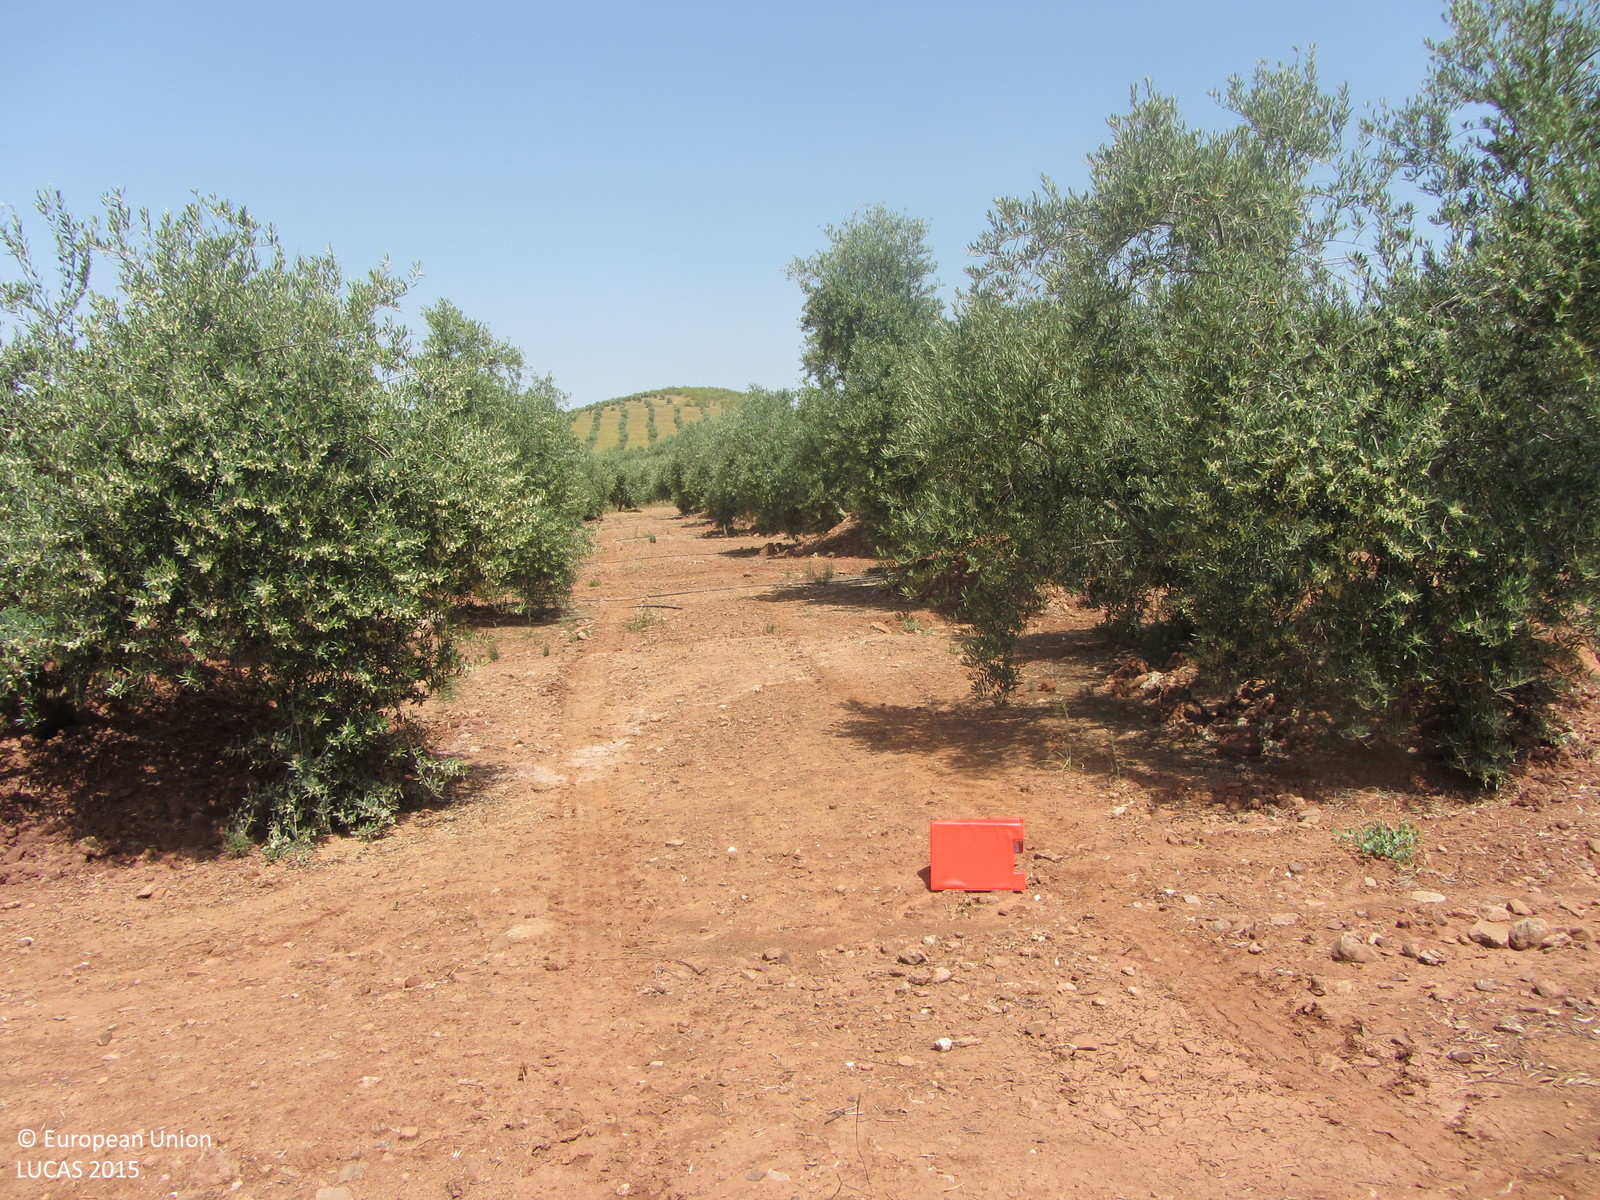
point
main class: Cropland
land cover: Olive groves
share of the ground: 50 - 75 %
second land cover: Other bare soil
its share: > 75 %
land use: Agriculture (excluding fallow land and kitchen gardens)
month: May
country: ES
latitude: 38.2784
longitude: -3.0209
